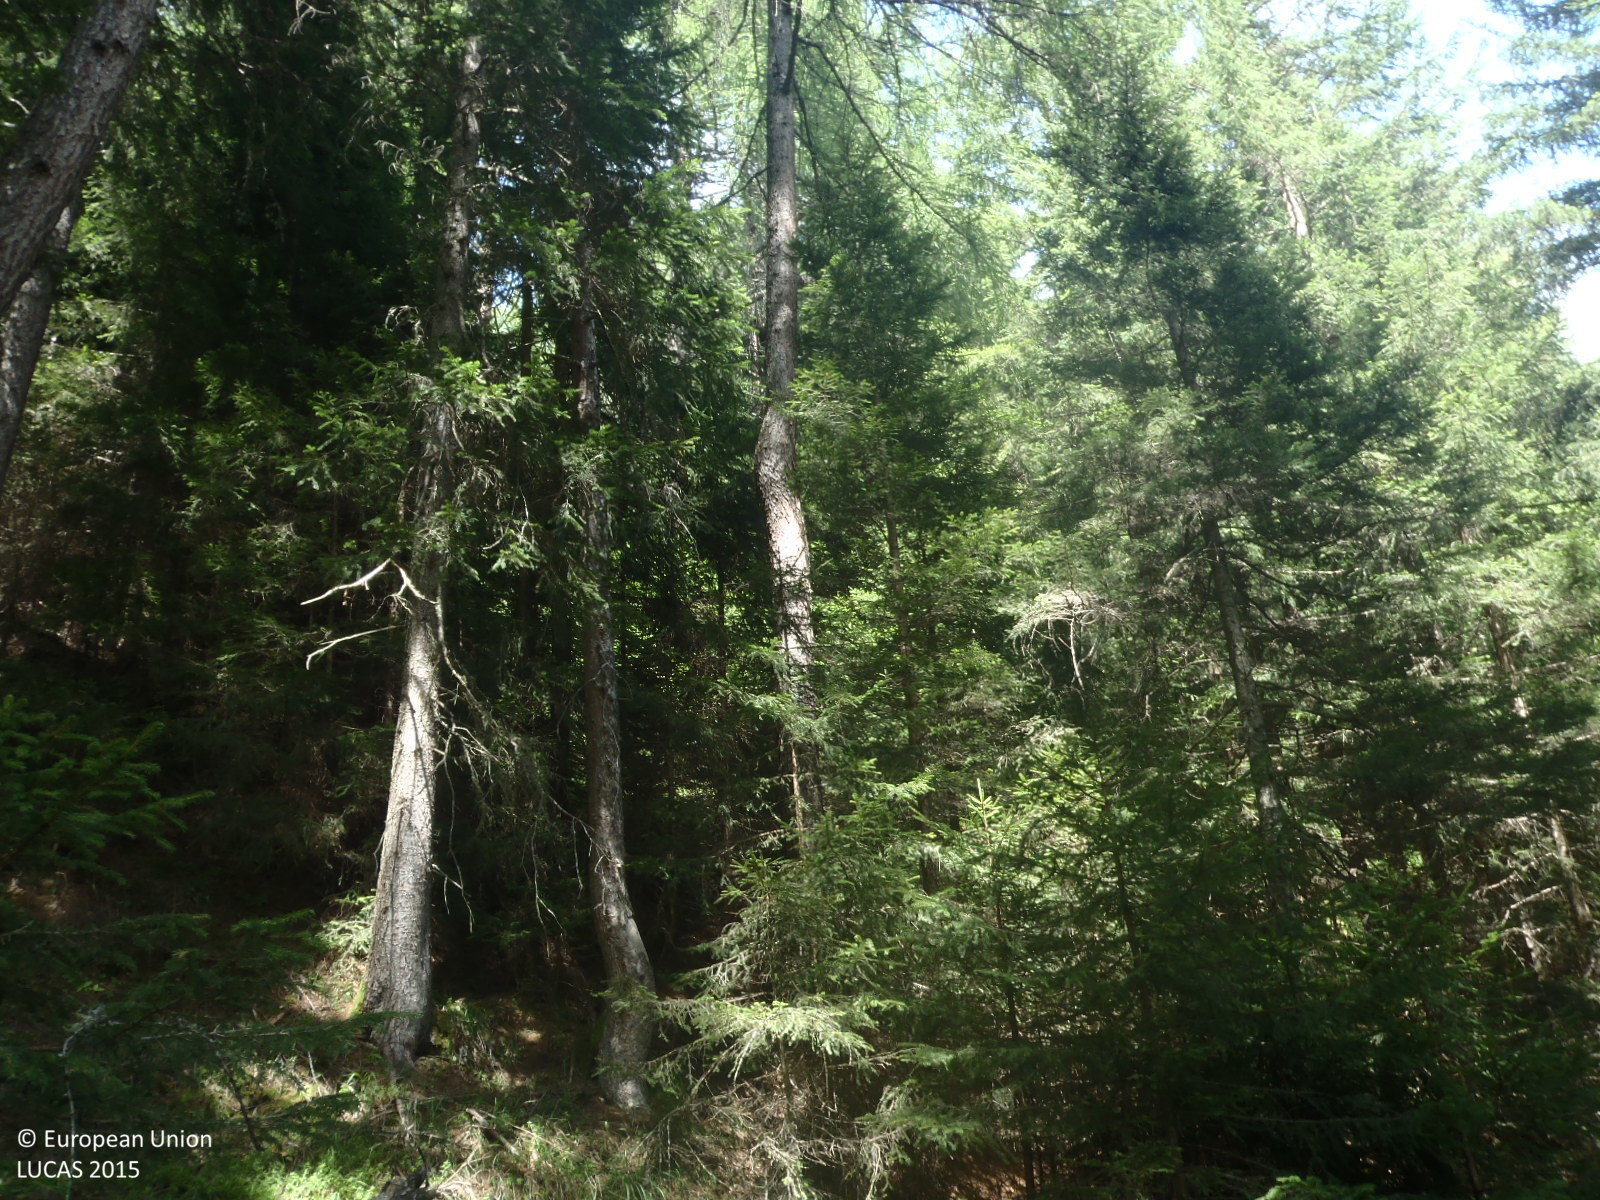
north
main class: Woodland
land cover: Spruce dominated coniferous woodland
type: alpine coniferous forest
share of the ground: > 75 %
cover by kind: coniferous forest trees 90 %, herbaceous plants 10 %
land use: Forestry
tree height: > 5 m
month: August
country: AT
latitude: 47.0064
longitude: 12.5100
